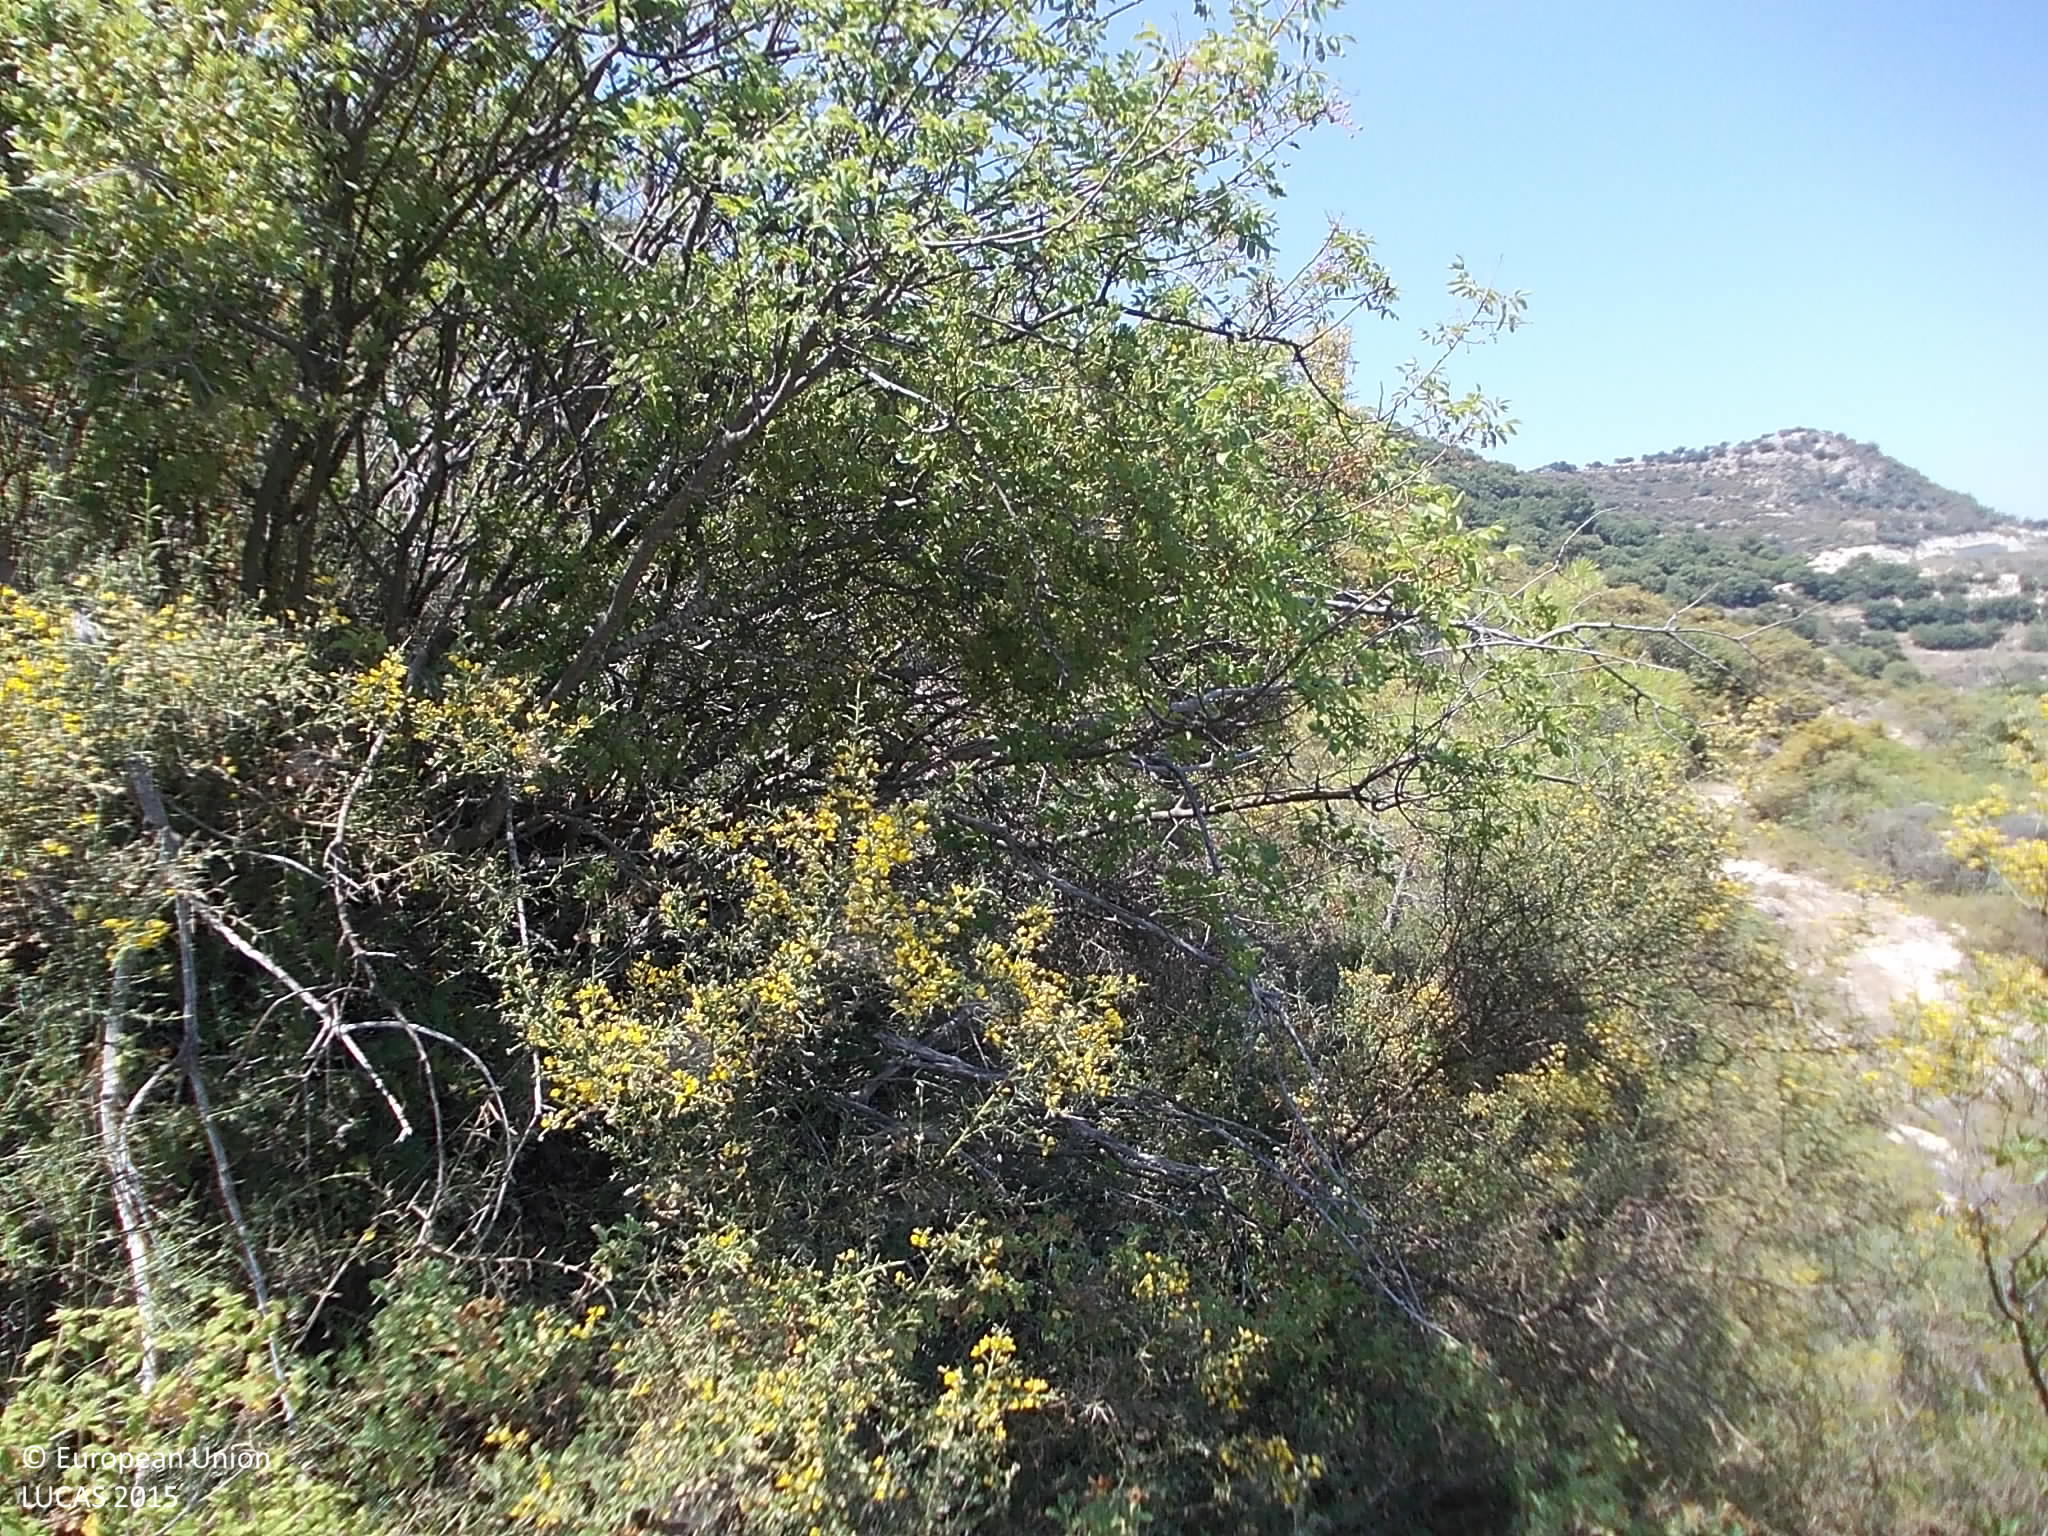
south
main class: Woodland
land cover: Broadleaved woodland
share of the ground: 10 - 25 %
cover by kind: shrubs 60 %, broadleaved forest trees 20 %, herbaceous plants 10 %, coniferous forest trees 5 %, unconsolidated bare surface 5 %
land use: Semi-natural and natural areas not in use
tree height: < 5 m
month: July
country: CY
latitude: 34.7717
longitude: 32.7187
